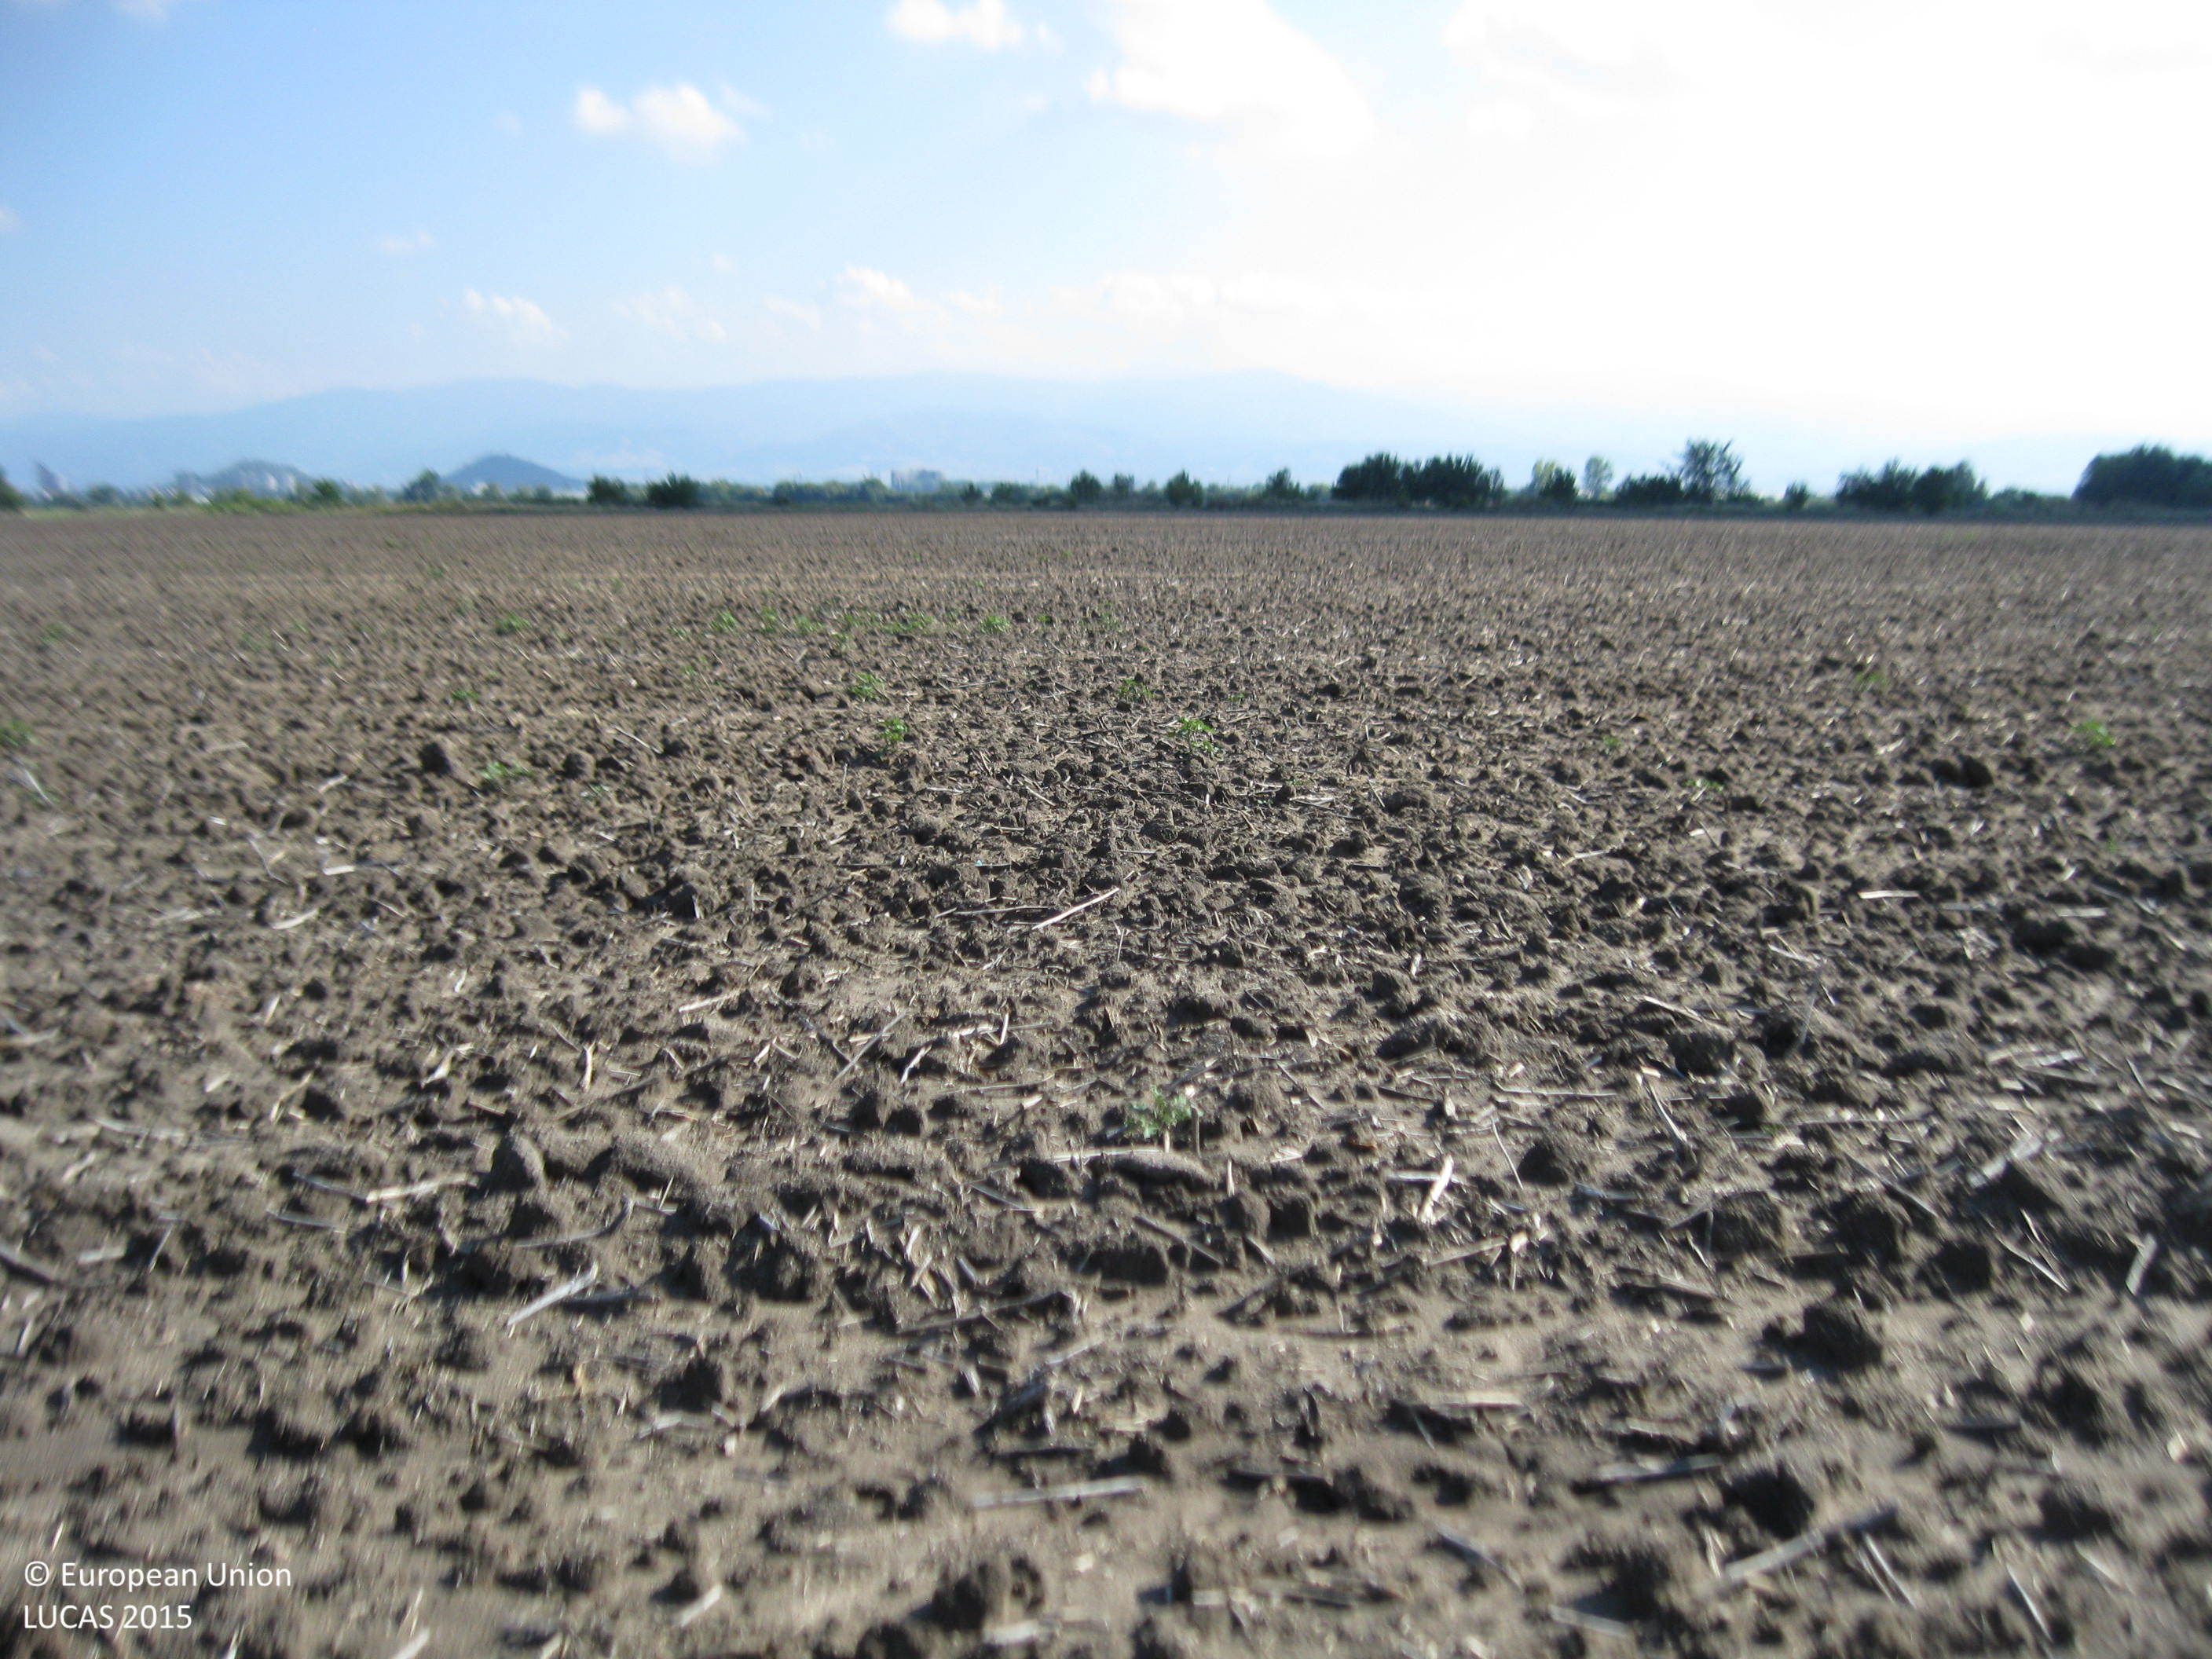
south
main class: Cropland
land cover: Sunflower
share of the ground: < 10 %
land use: Agriculture (excluding fallow land and kitchen gardens)
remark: Tilled/Sowed
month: August
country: BG
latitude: 42.1954
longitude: 24.7166
